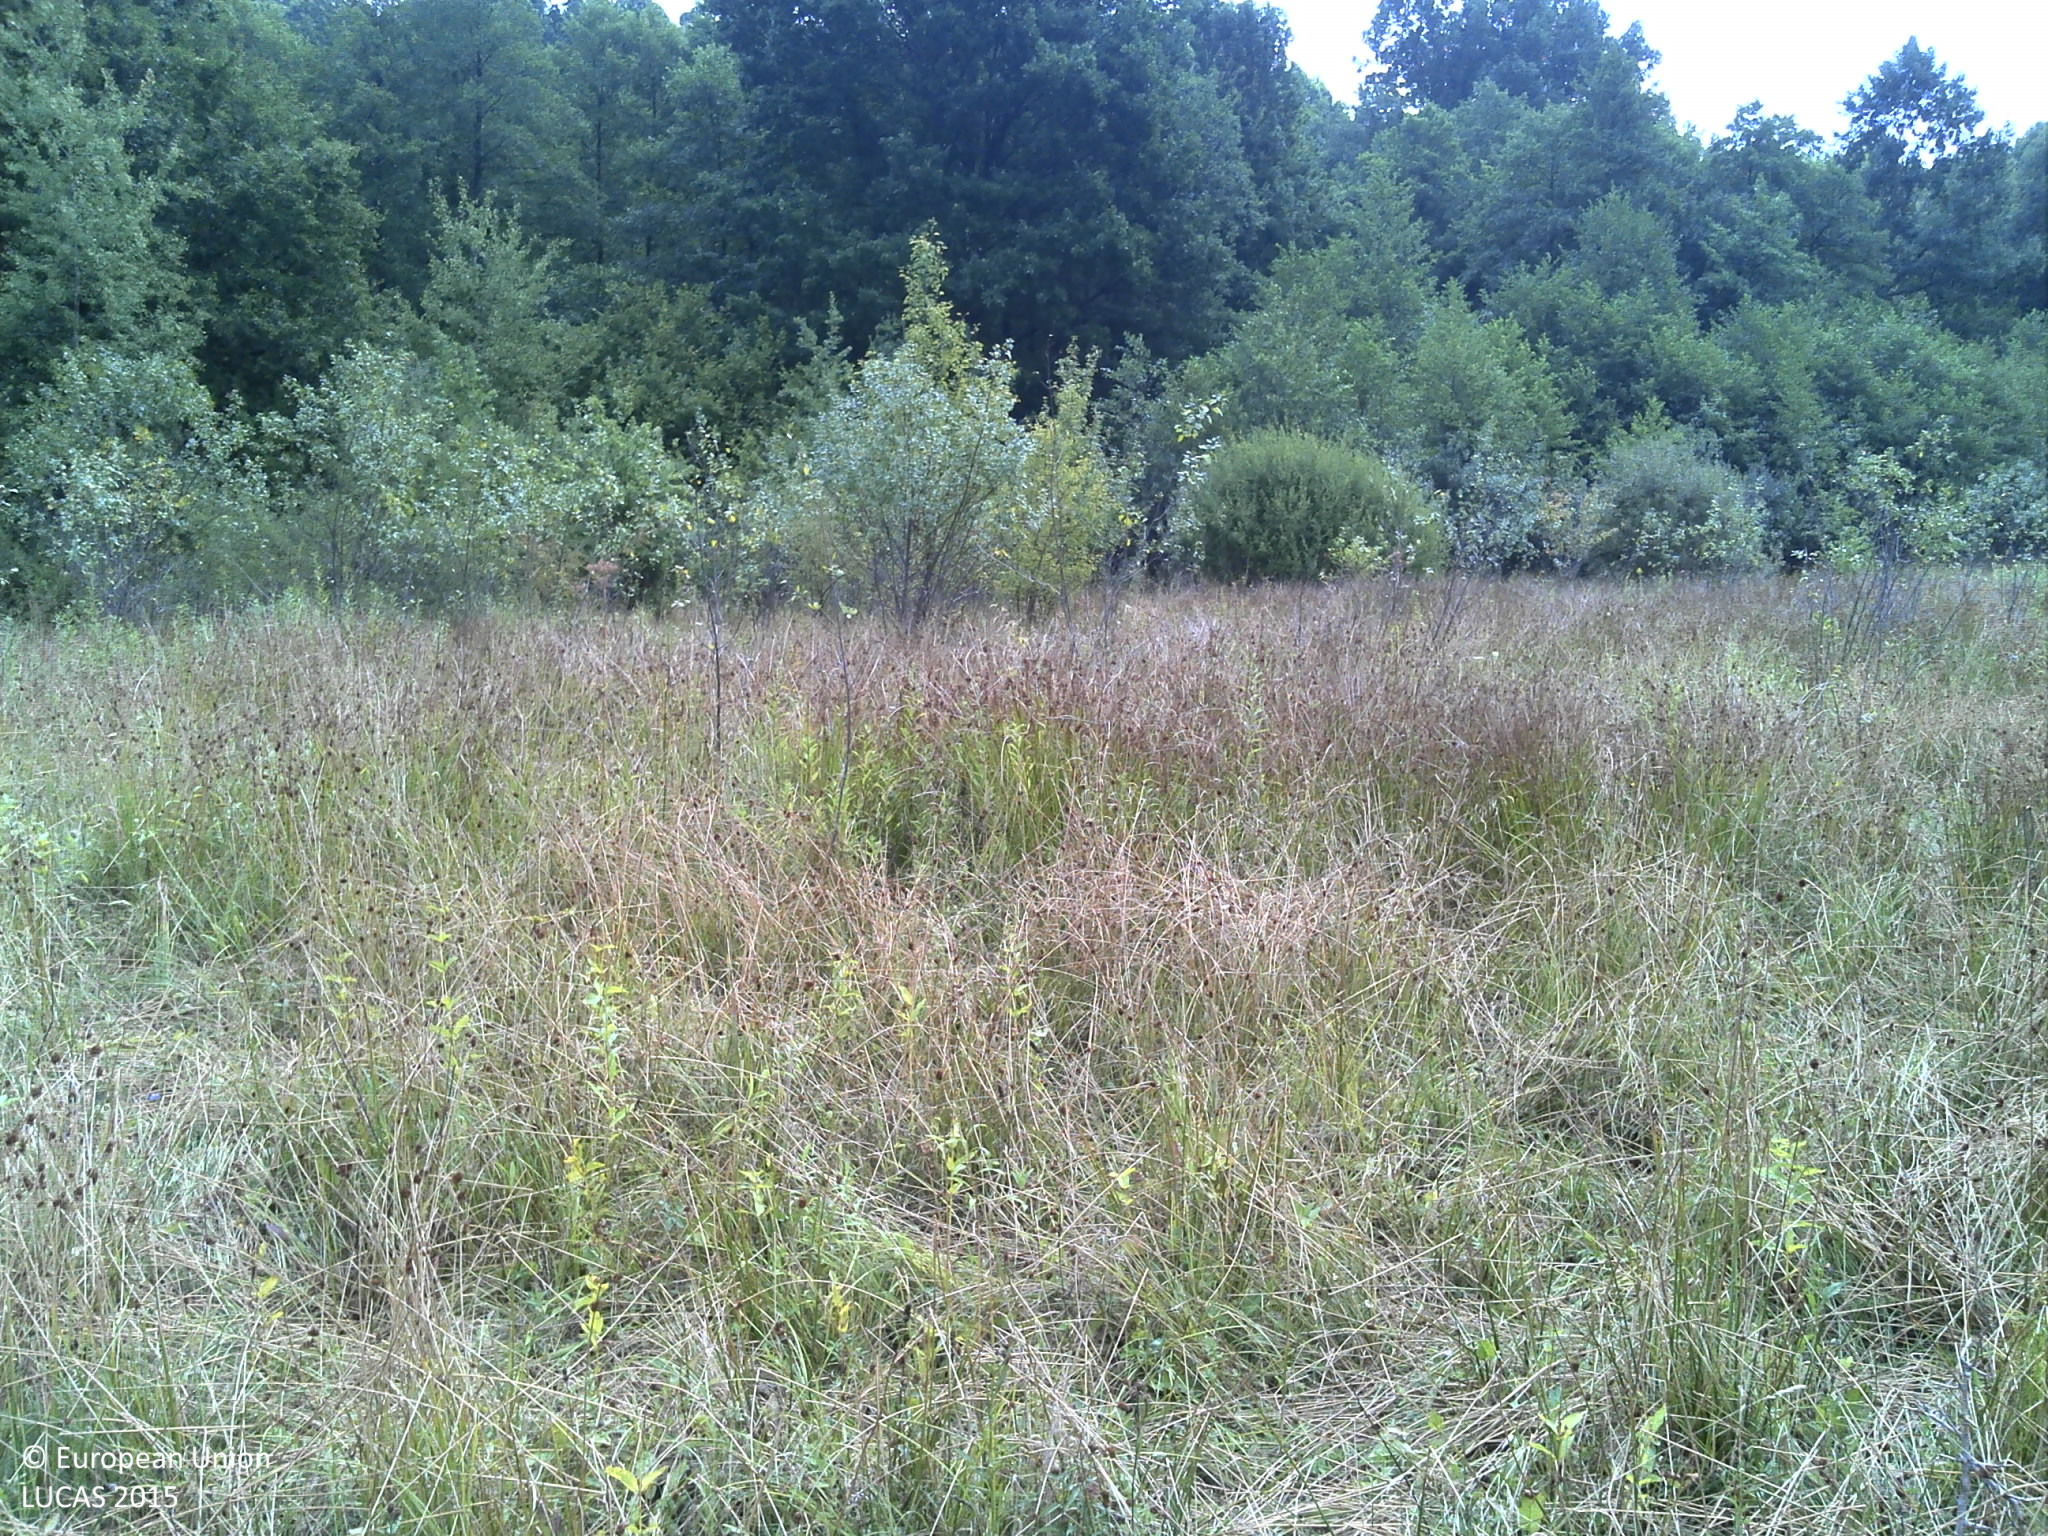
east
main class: Grassland
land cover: Spontaneously vegetated surfaces
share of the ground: > 75 %
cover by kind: herbaceous plants 100 %
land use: Fallow land
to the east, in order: Spontaneously vegetated surfaces; Groves; Broadleaved woodland
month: August
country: HR
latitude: 45.4066
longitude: 15.9890
